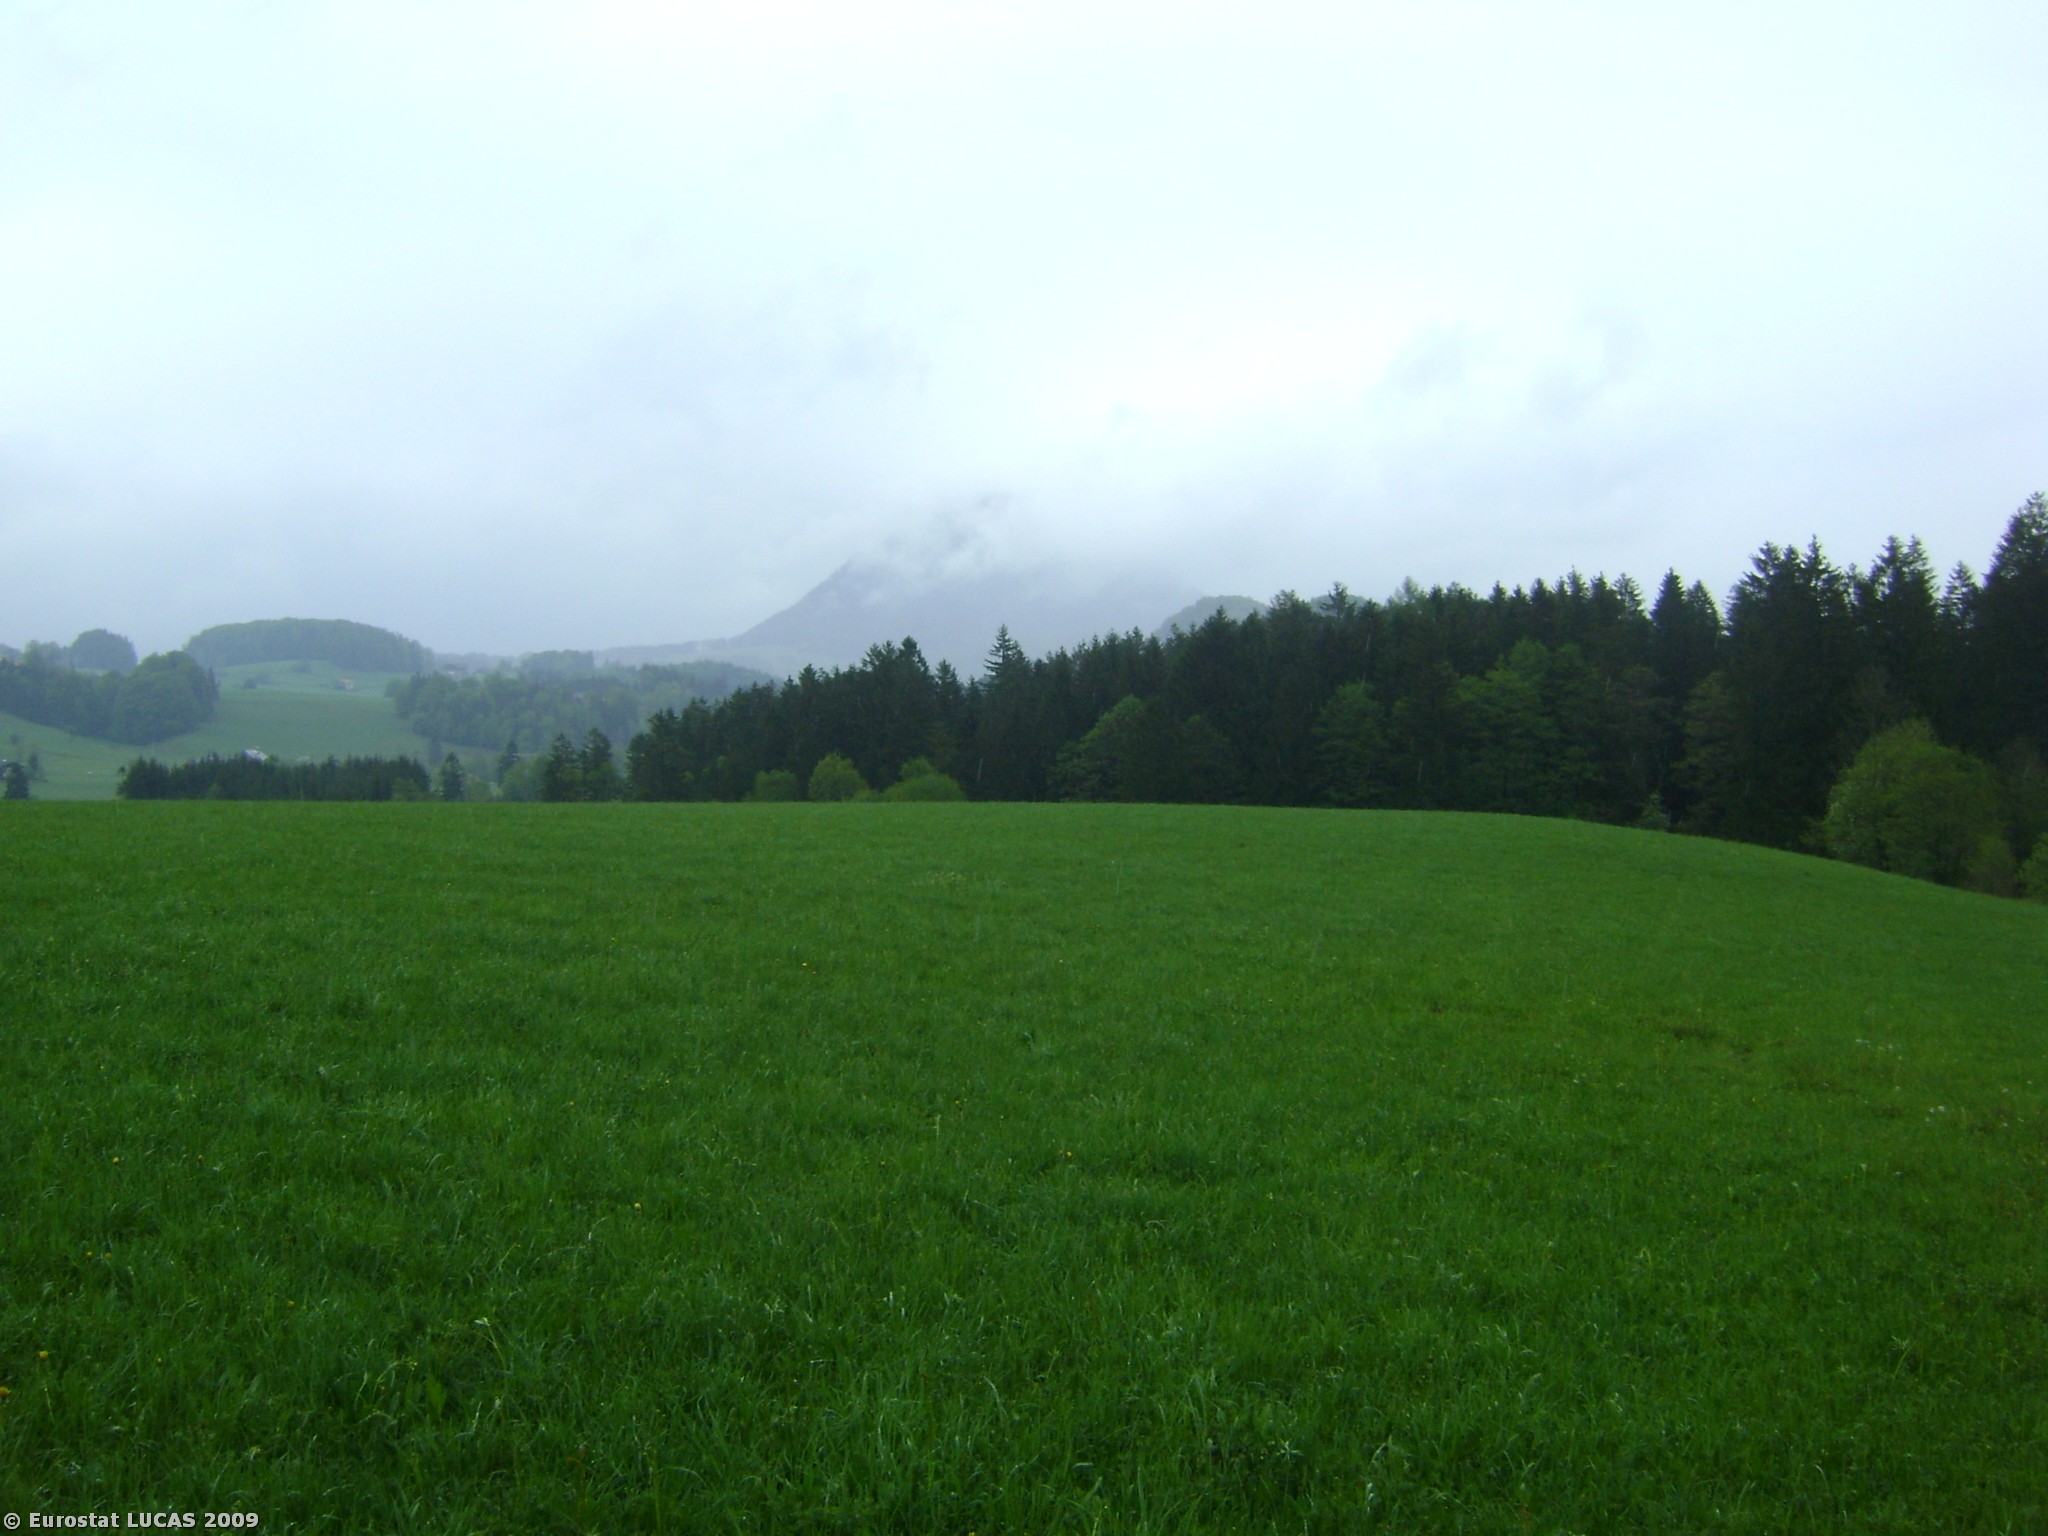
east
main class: Grassland
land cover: Grassland without tree/shrub cover
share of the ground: > 75 %
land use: Agriculture (excluding fallow land and kitchen gardens)
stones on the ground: < 10 %
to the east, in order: Grassland without tree/shrub cover; Ditches and canals; Grassland without tree/shrub cover; Inland marshes; Ditches and canals; Inland marshes; Mixed woodland
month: May
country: AT
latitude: 47.8156
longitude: 13.2440
